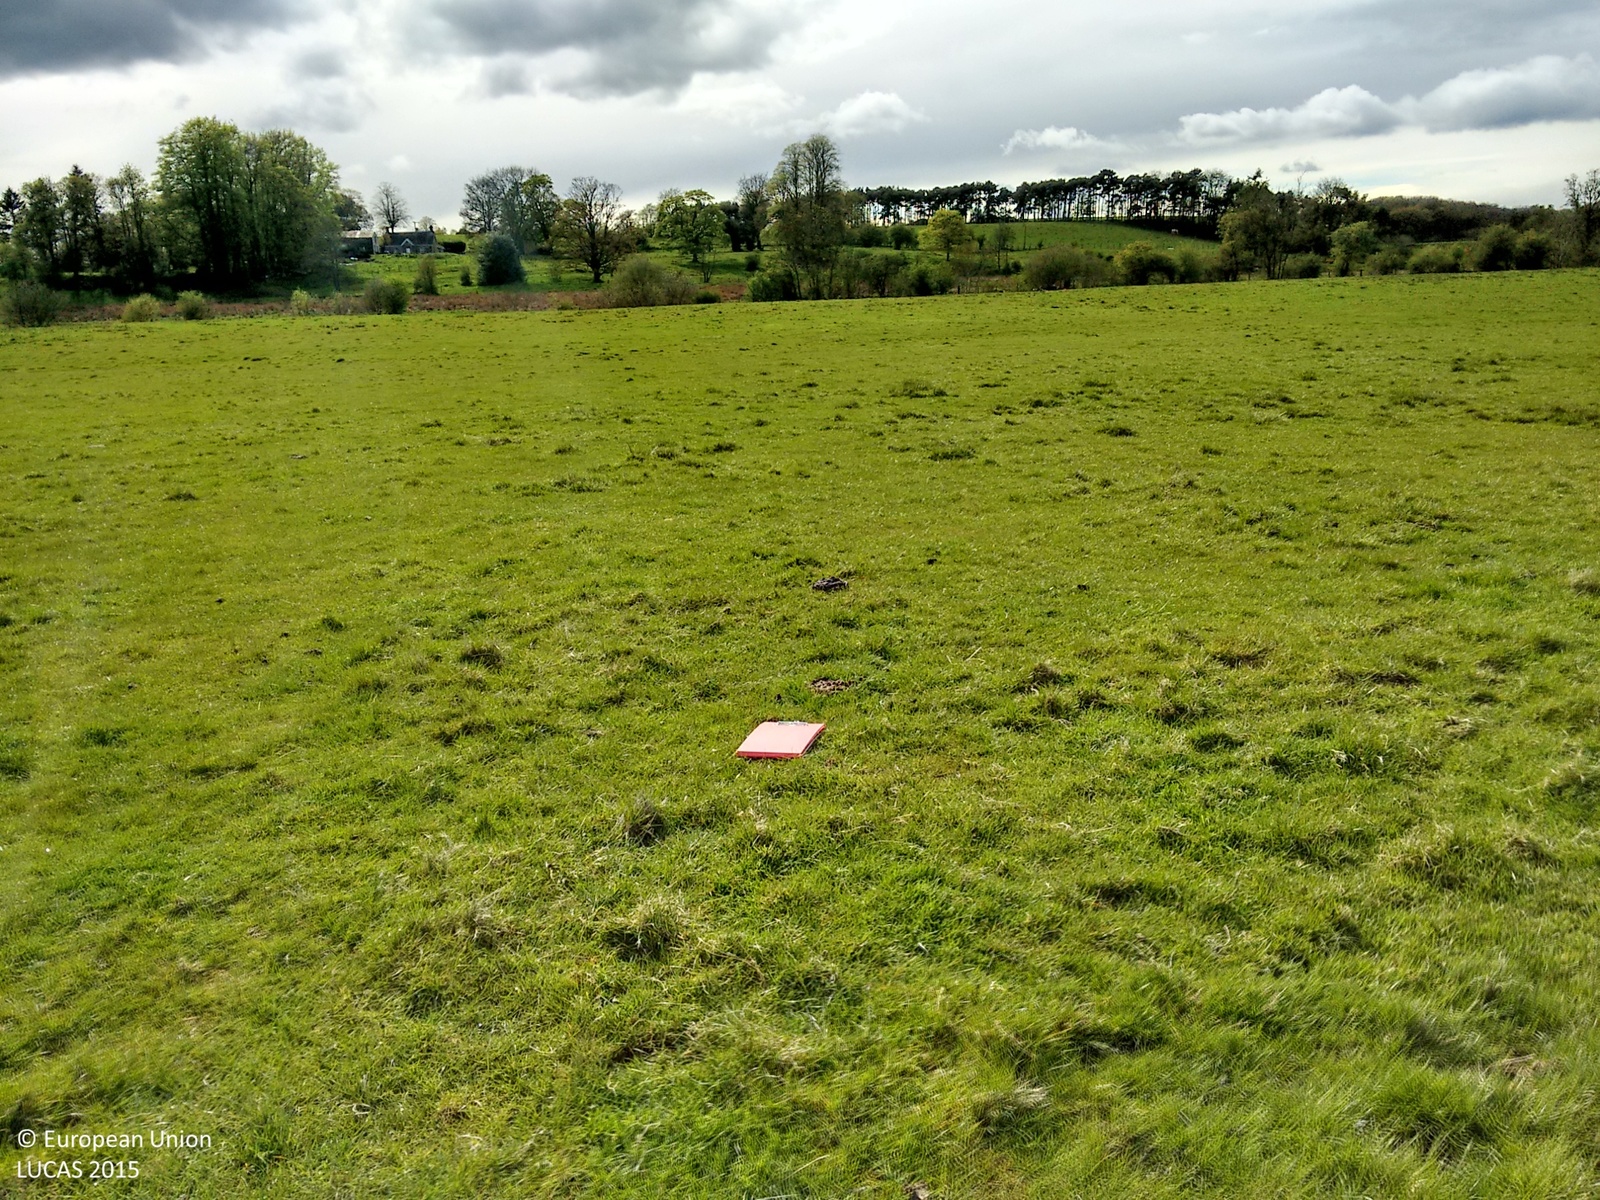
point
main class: Grassland
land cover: Grassland without tree/shrub cover
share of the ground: > 75 %
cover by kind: herbaceous plants 100 %
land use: Agriculture (excluding fallow land and kitchen gardens)
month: May
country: GB
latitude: 56.0747
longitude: -3.8194
